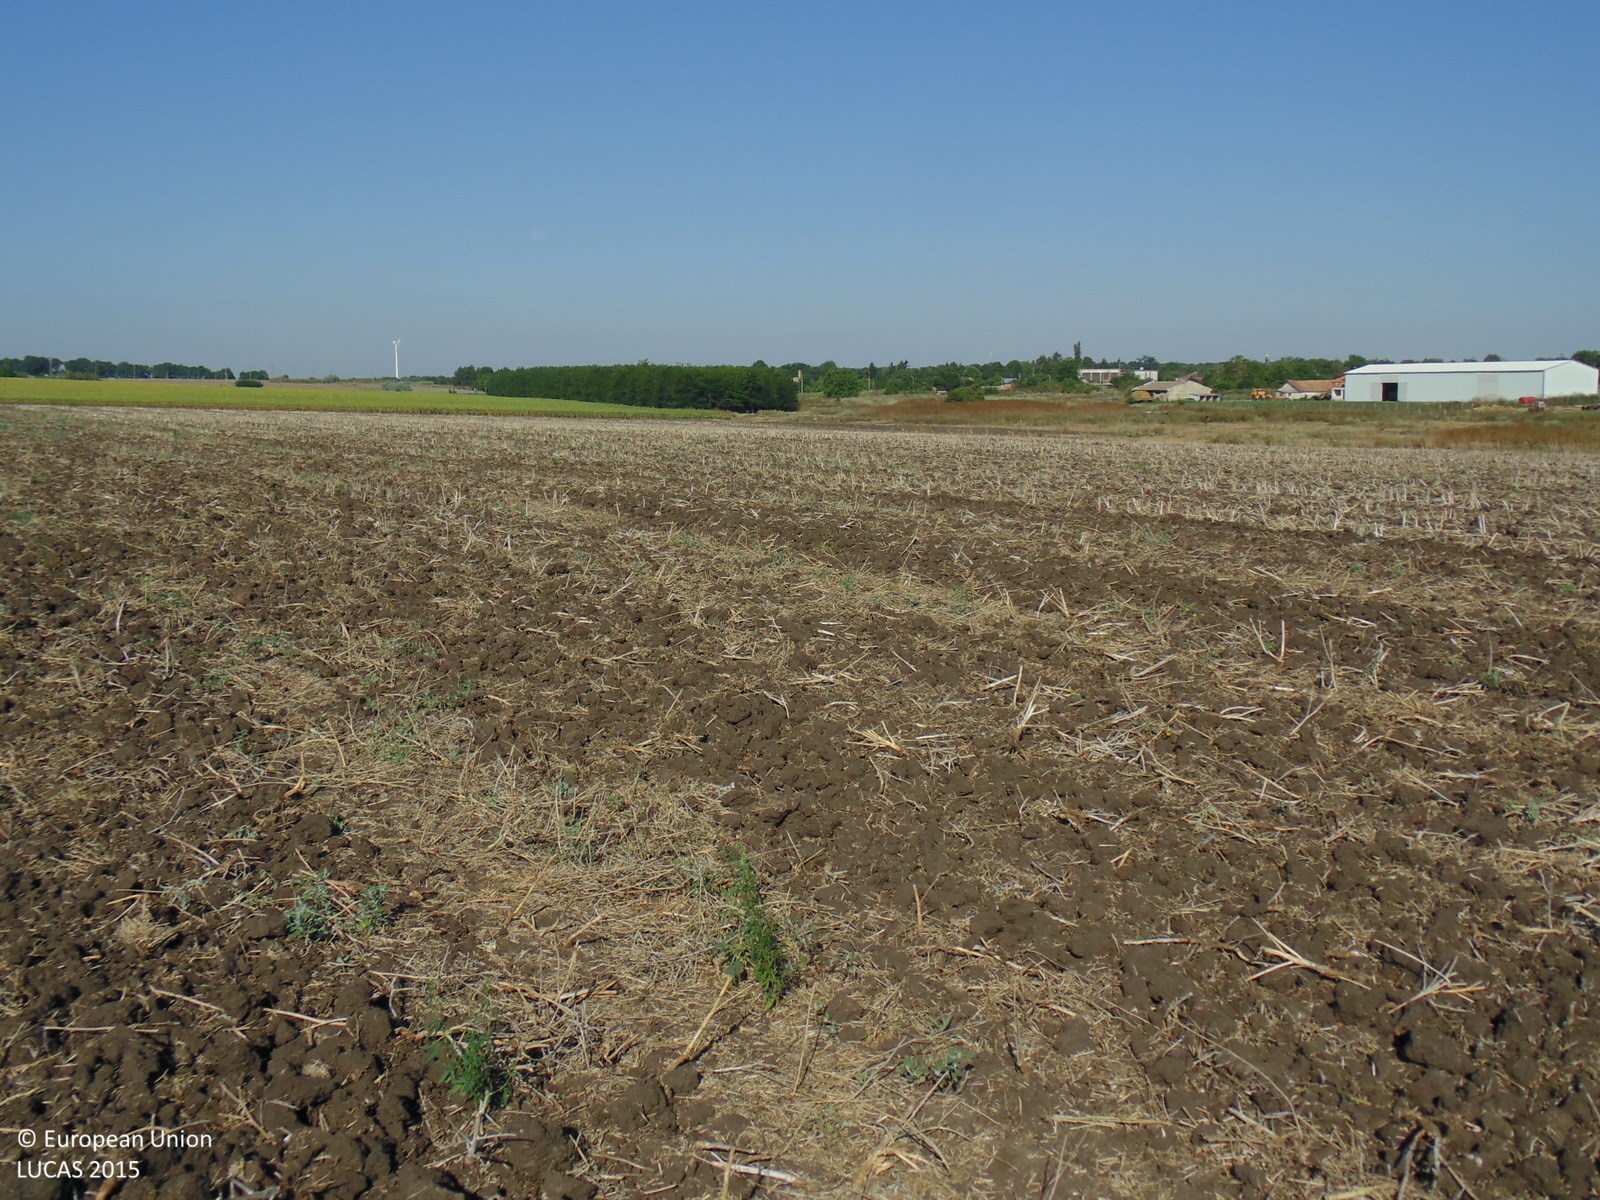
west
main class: Cropland
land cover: Rape and turnip rape
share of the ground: < 10 %
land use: Agriculture (excluding fallow land and kitchen gardens)
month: August
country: BG
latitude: 43.5742
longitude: 28.0918
